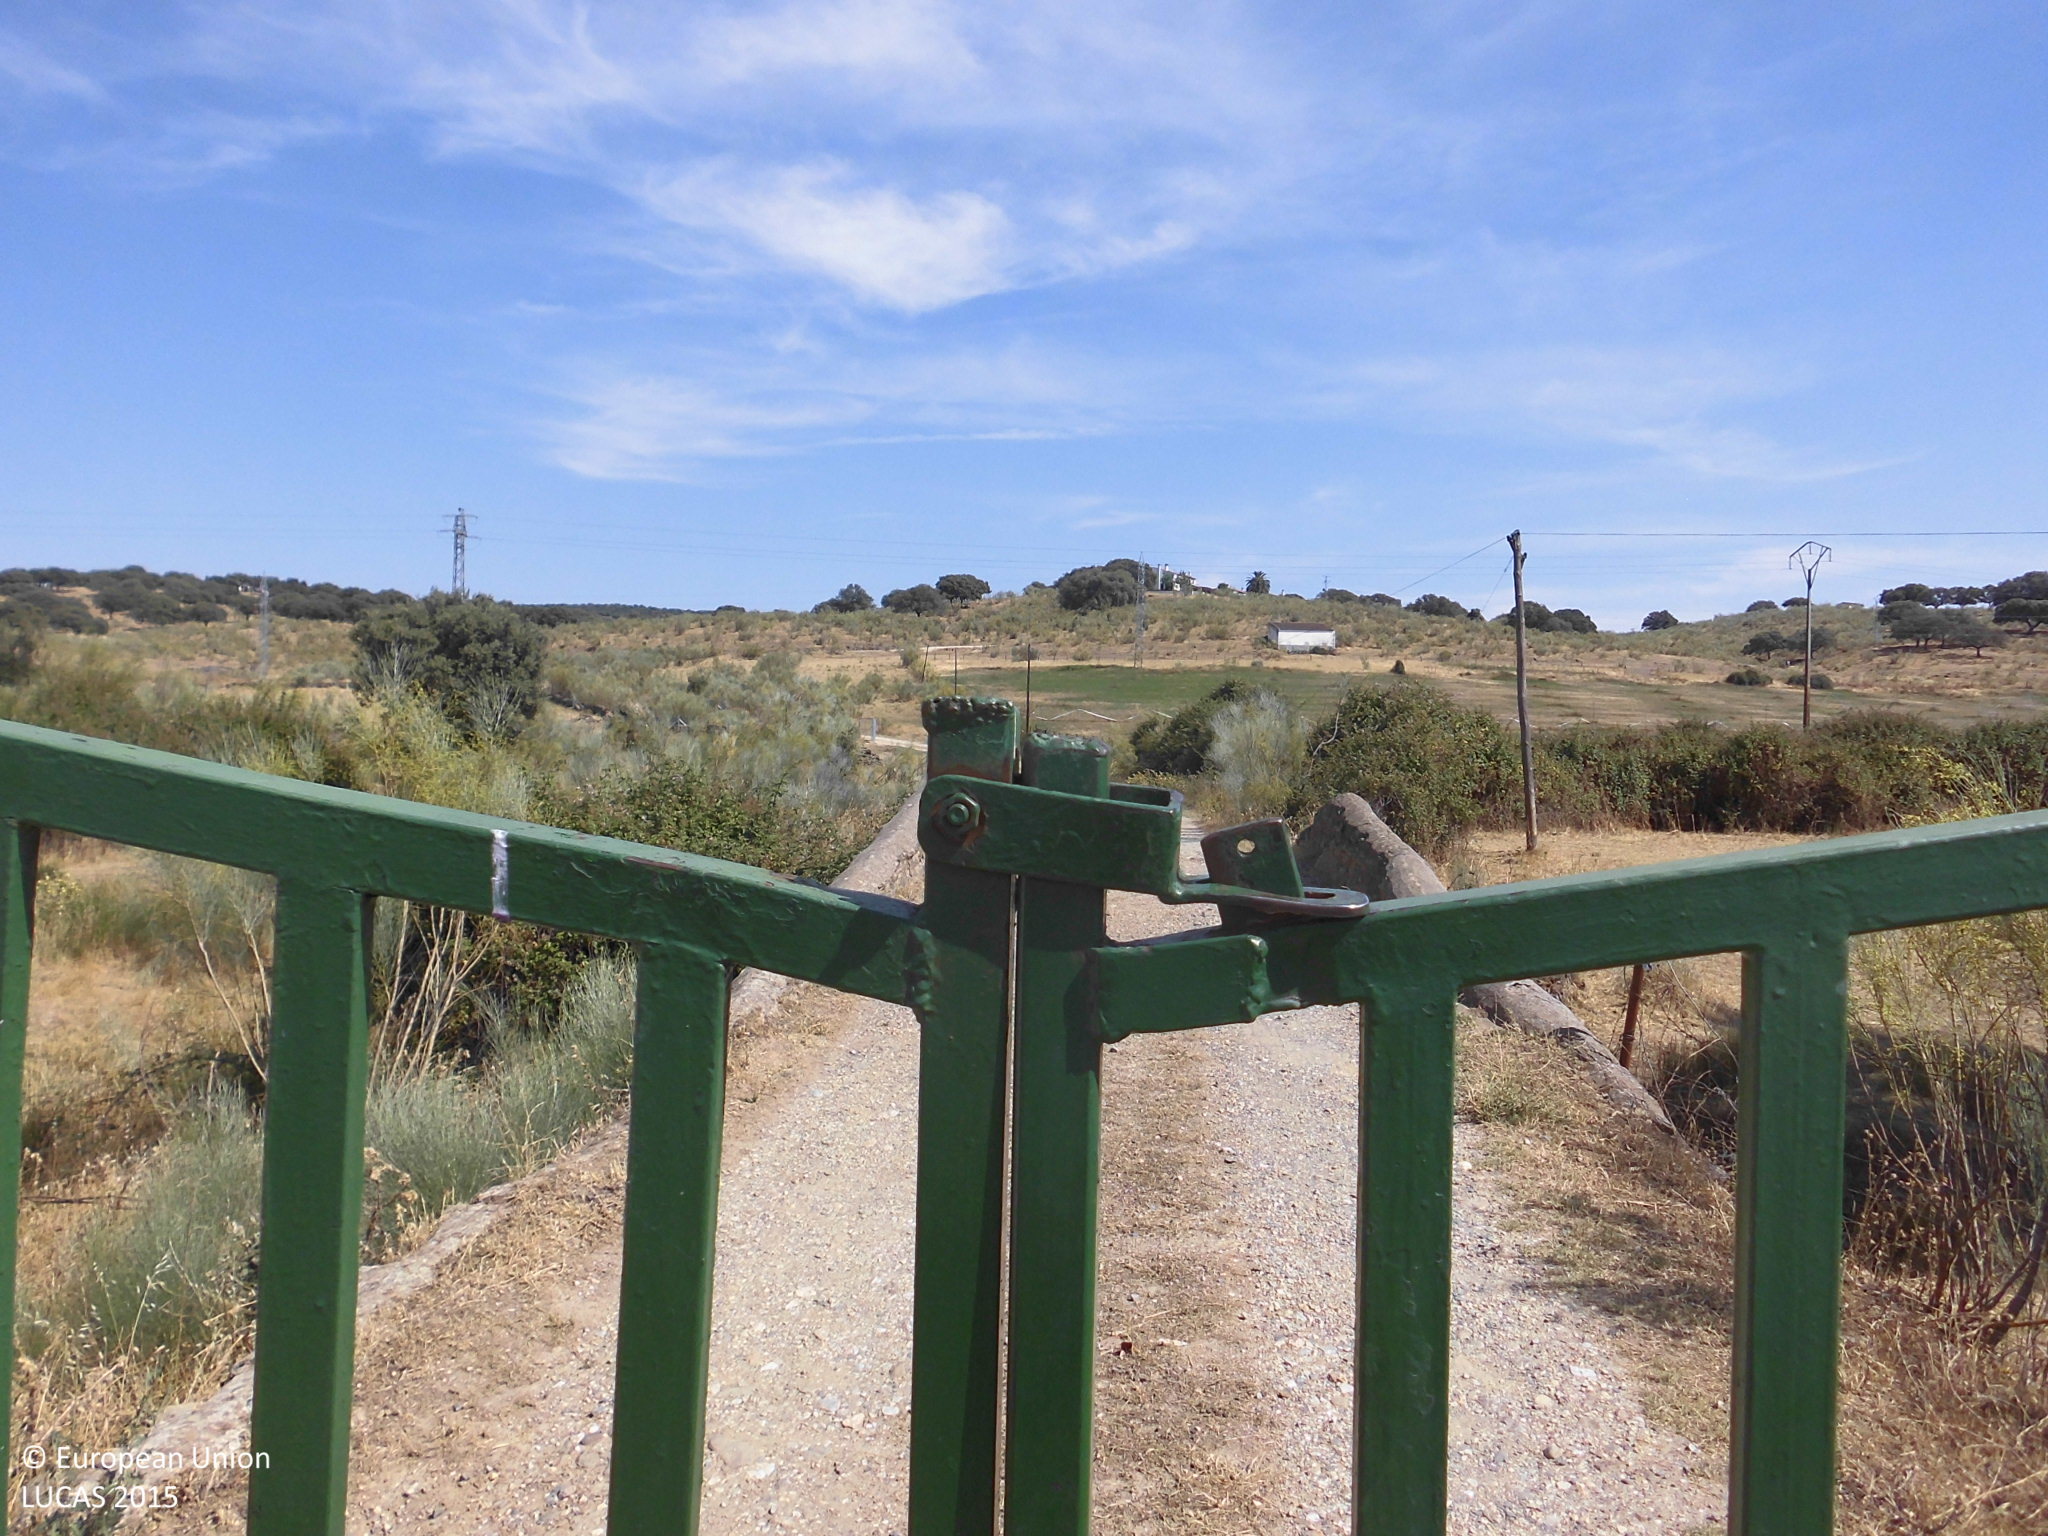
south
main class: Woodland
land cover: Broadleaved woodland
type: broadleaved evergreen forest
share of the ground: 50 - 75 %
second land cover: Grassland without tree/shrub cover
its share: > 75 %
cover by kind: broadleaved forest trees 50 %, herbaceous plants 50 %
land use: Forestry
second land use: Agriculture (excluding fallow land and kitchen gardens)
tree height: > 5 m
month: June
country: ES
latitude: 39.9223
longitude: -6.2064
